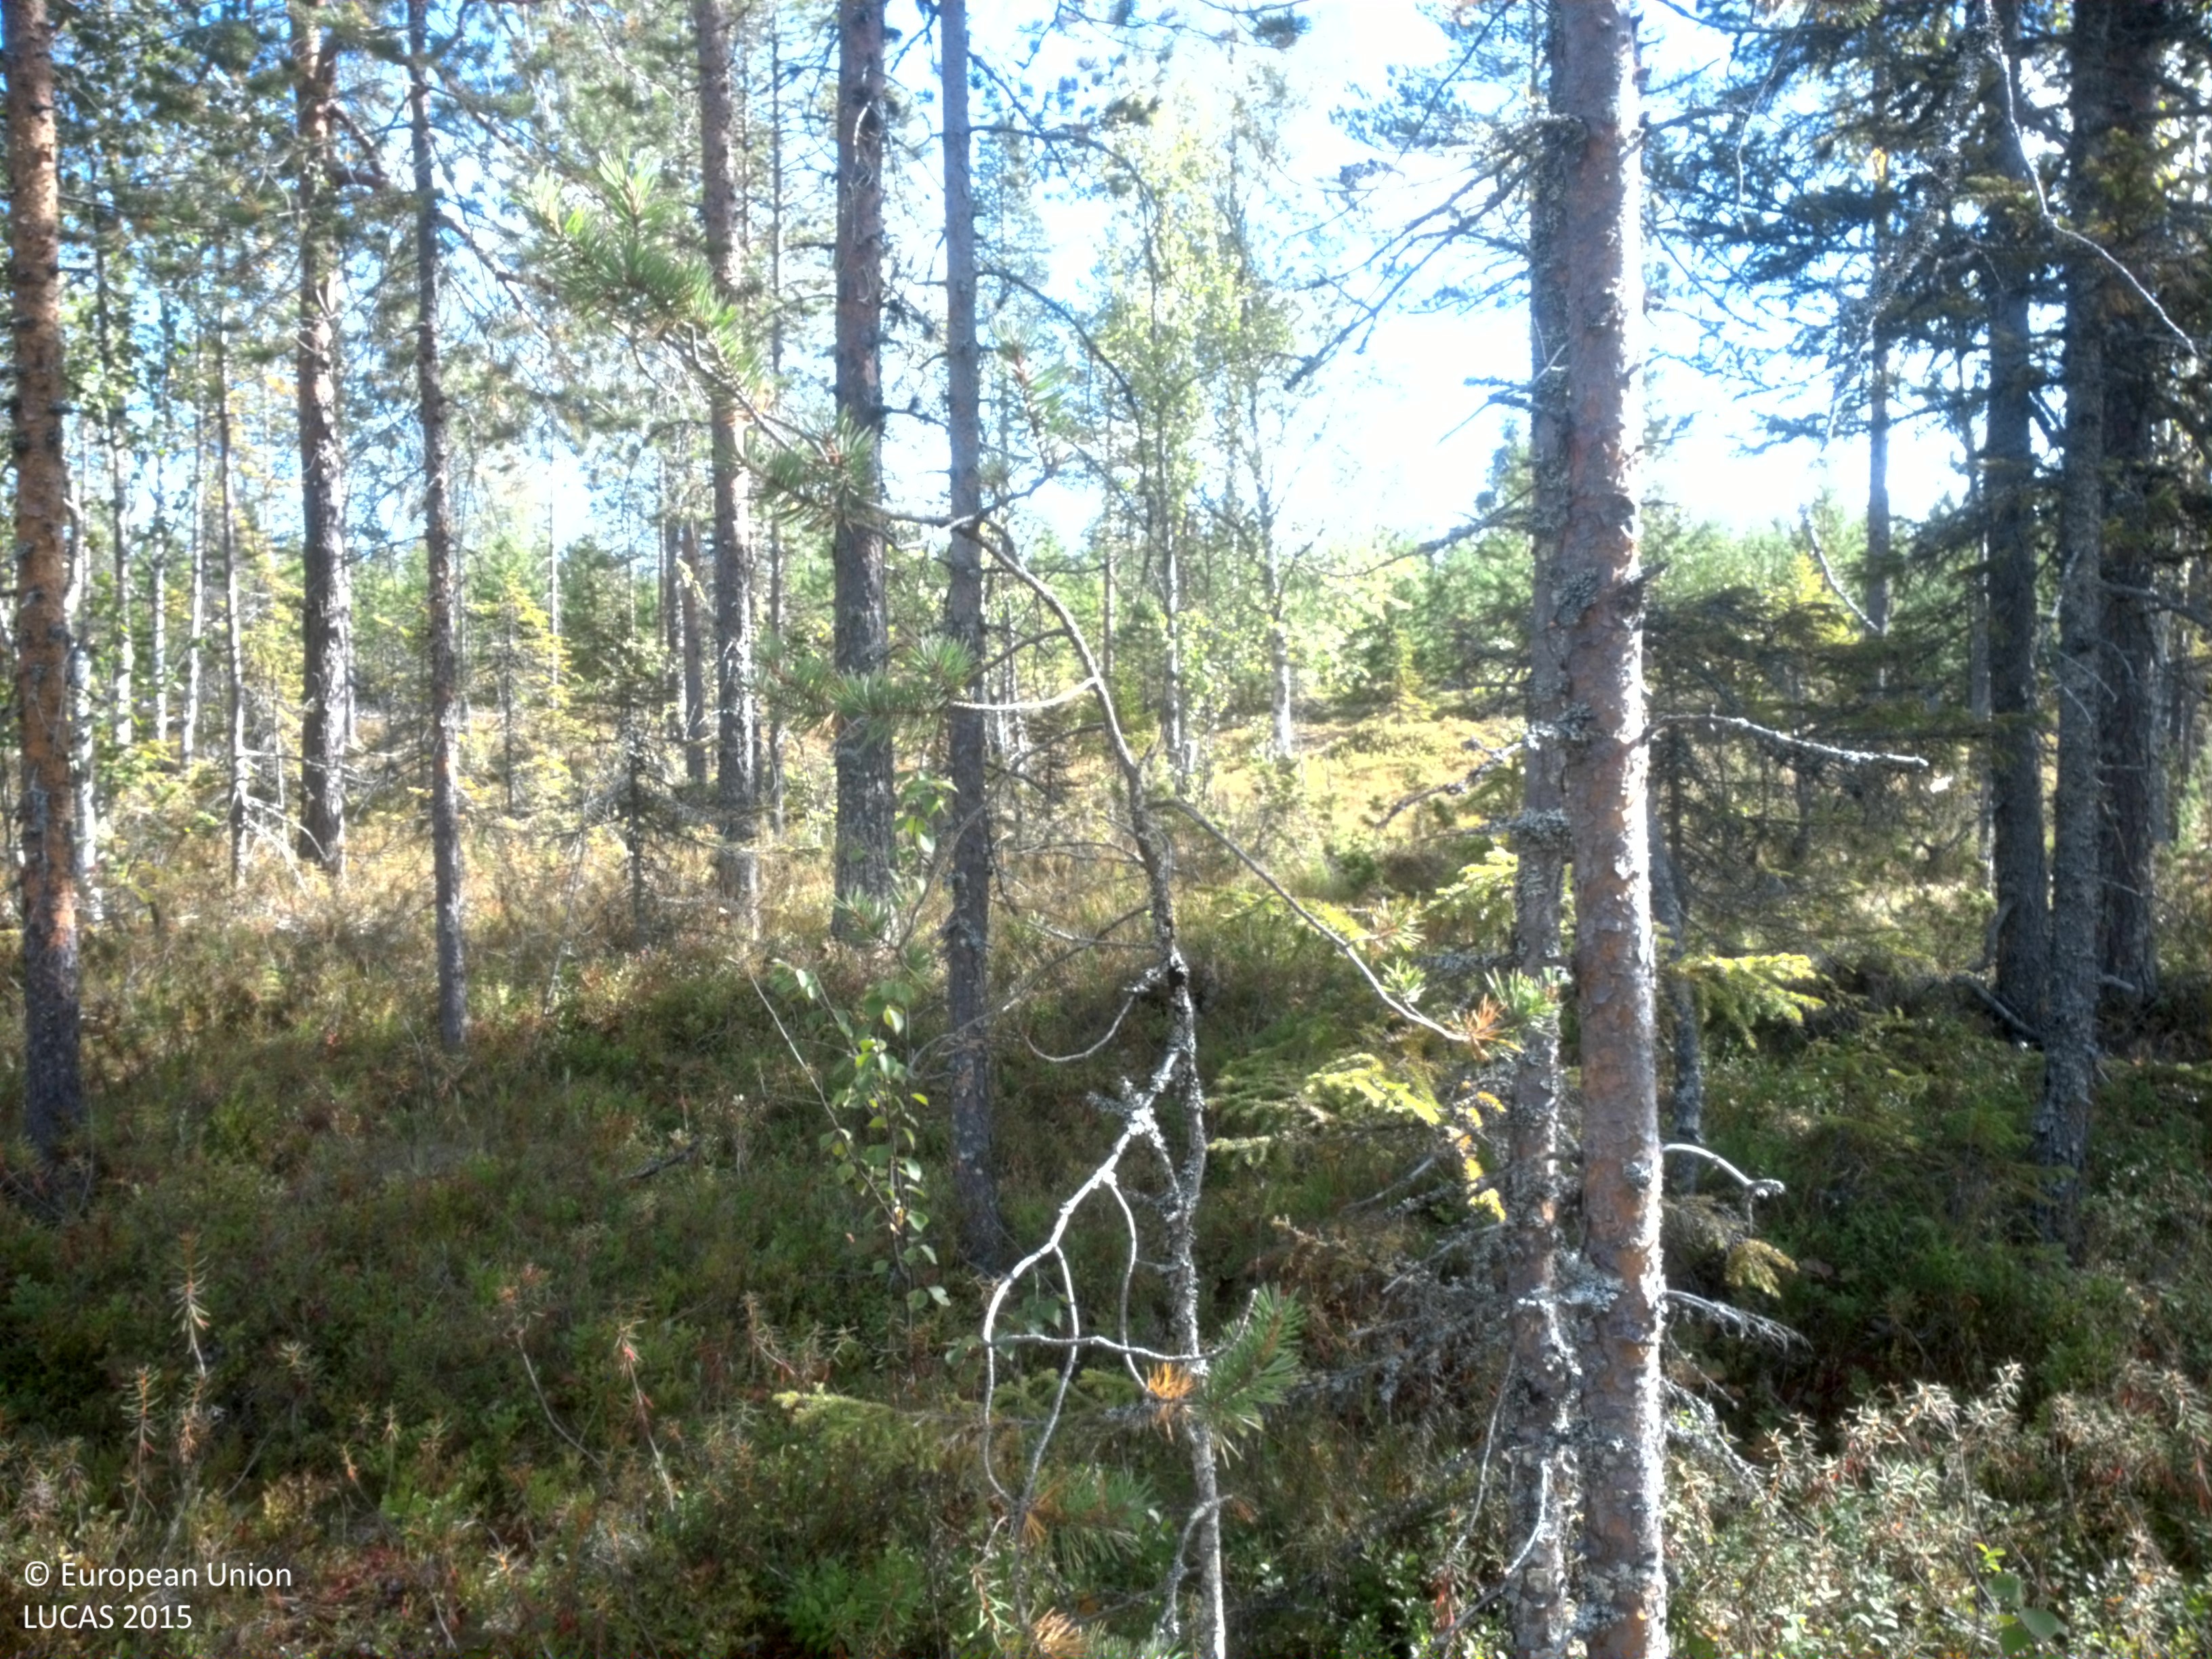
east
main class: Woodland
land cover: Pine dominated coniferous woodland
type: boreal forest
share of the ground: 50 - 75 %
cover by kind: coniferous forest trees 55 %, shrubs 20 %, lichens and mosses 15 %, herbaceous plants 10 %
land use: Forestry
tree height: > 5 m
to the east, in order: Pine dominated coniferous woodland; Pine dominated mixed woodland; Pine dominated coniferous woodland; Other mixed woodland; Other coniferous woodland; Pine dominated coniferous woodland
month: September
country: SE
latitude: 64.5715
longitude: 19.1328
